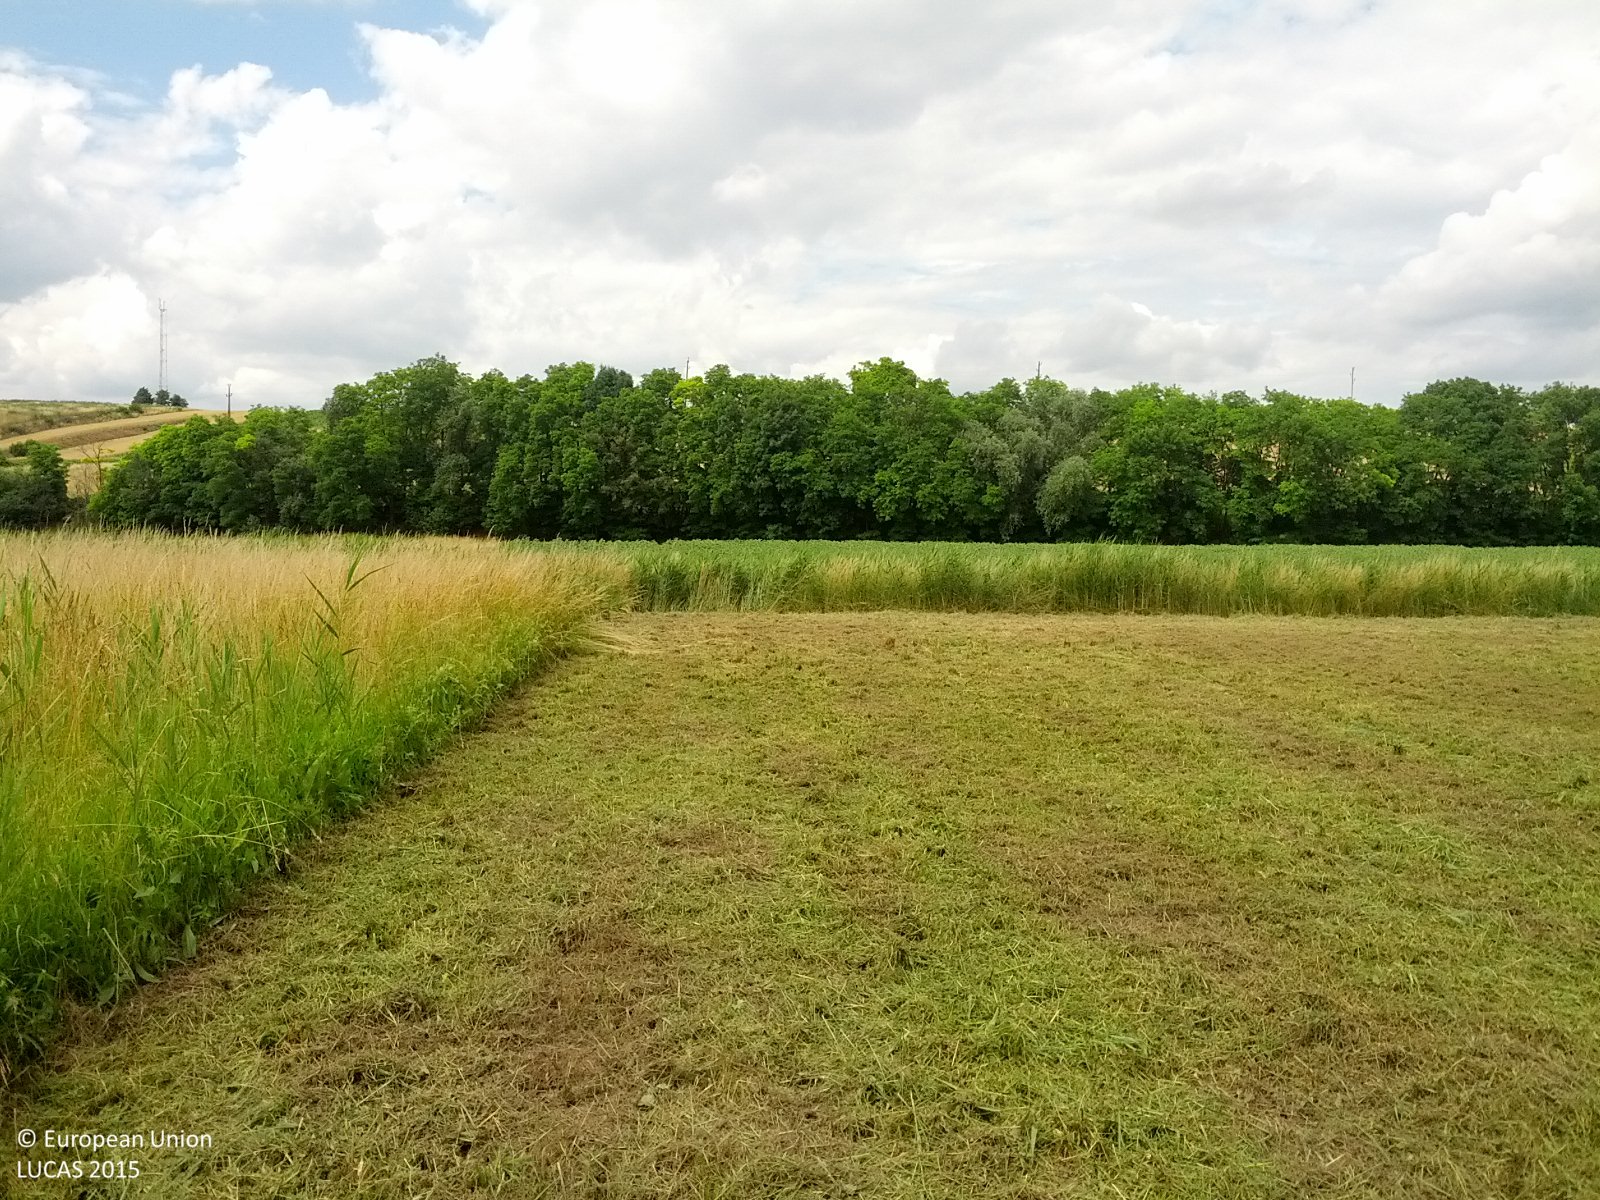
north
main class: Grassland
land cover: Grassland without tree/shrub cover
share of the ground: > 75 %
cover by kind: herbaceous plants 100 %
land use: Agriculture (excluding fallow land and kitchen gardens)
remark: Harvested field
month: June
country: AT
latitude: 48.4643
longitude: 16.8099
